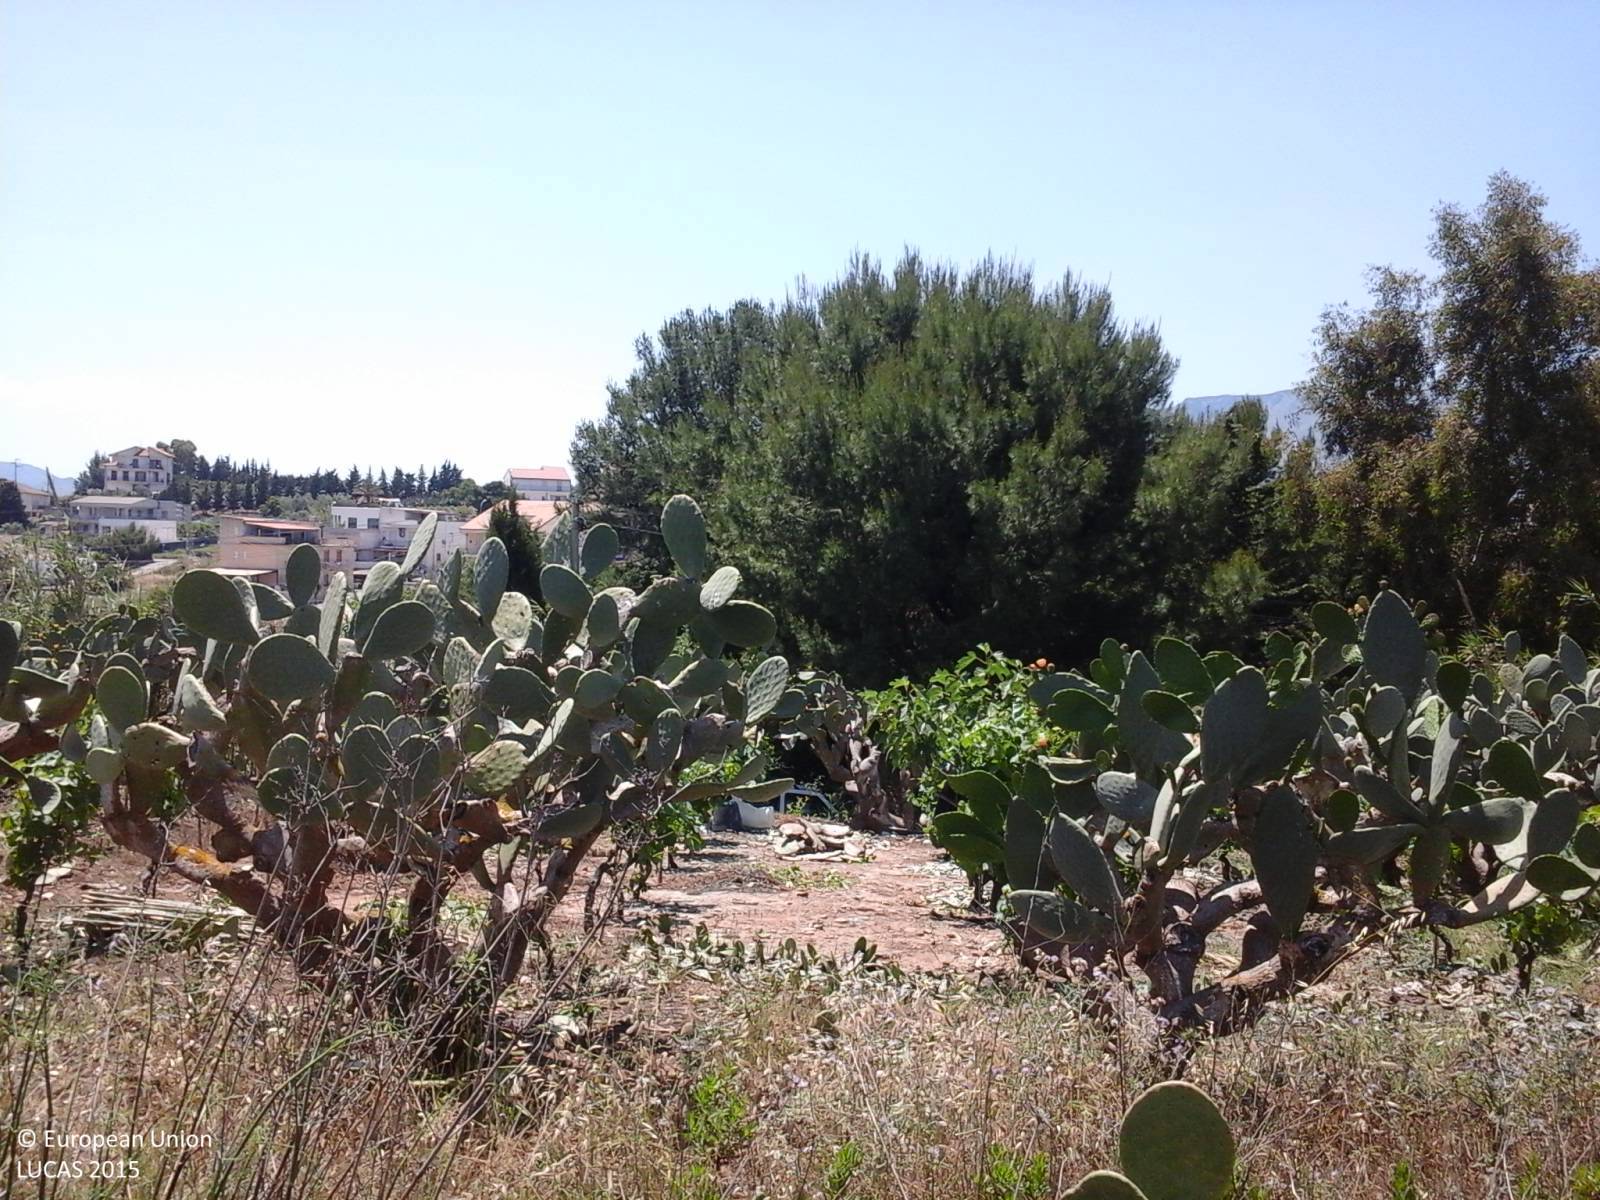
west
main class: Grassland
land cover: Grassland without tree/shrub cover
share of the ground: > 75 %
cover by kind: herbaceous plants 100 %
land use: Abandoned areas
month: June
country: IT
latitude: 37.9924
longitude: 12.9507
